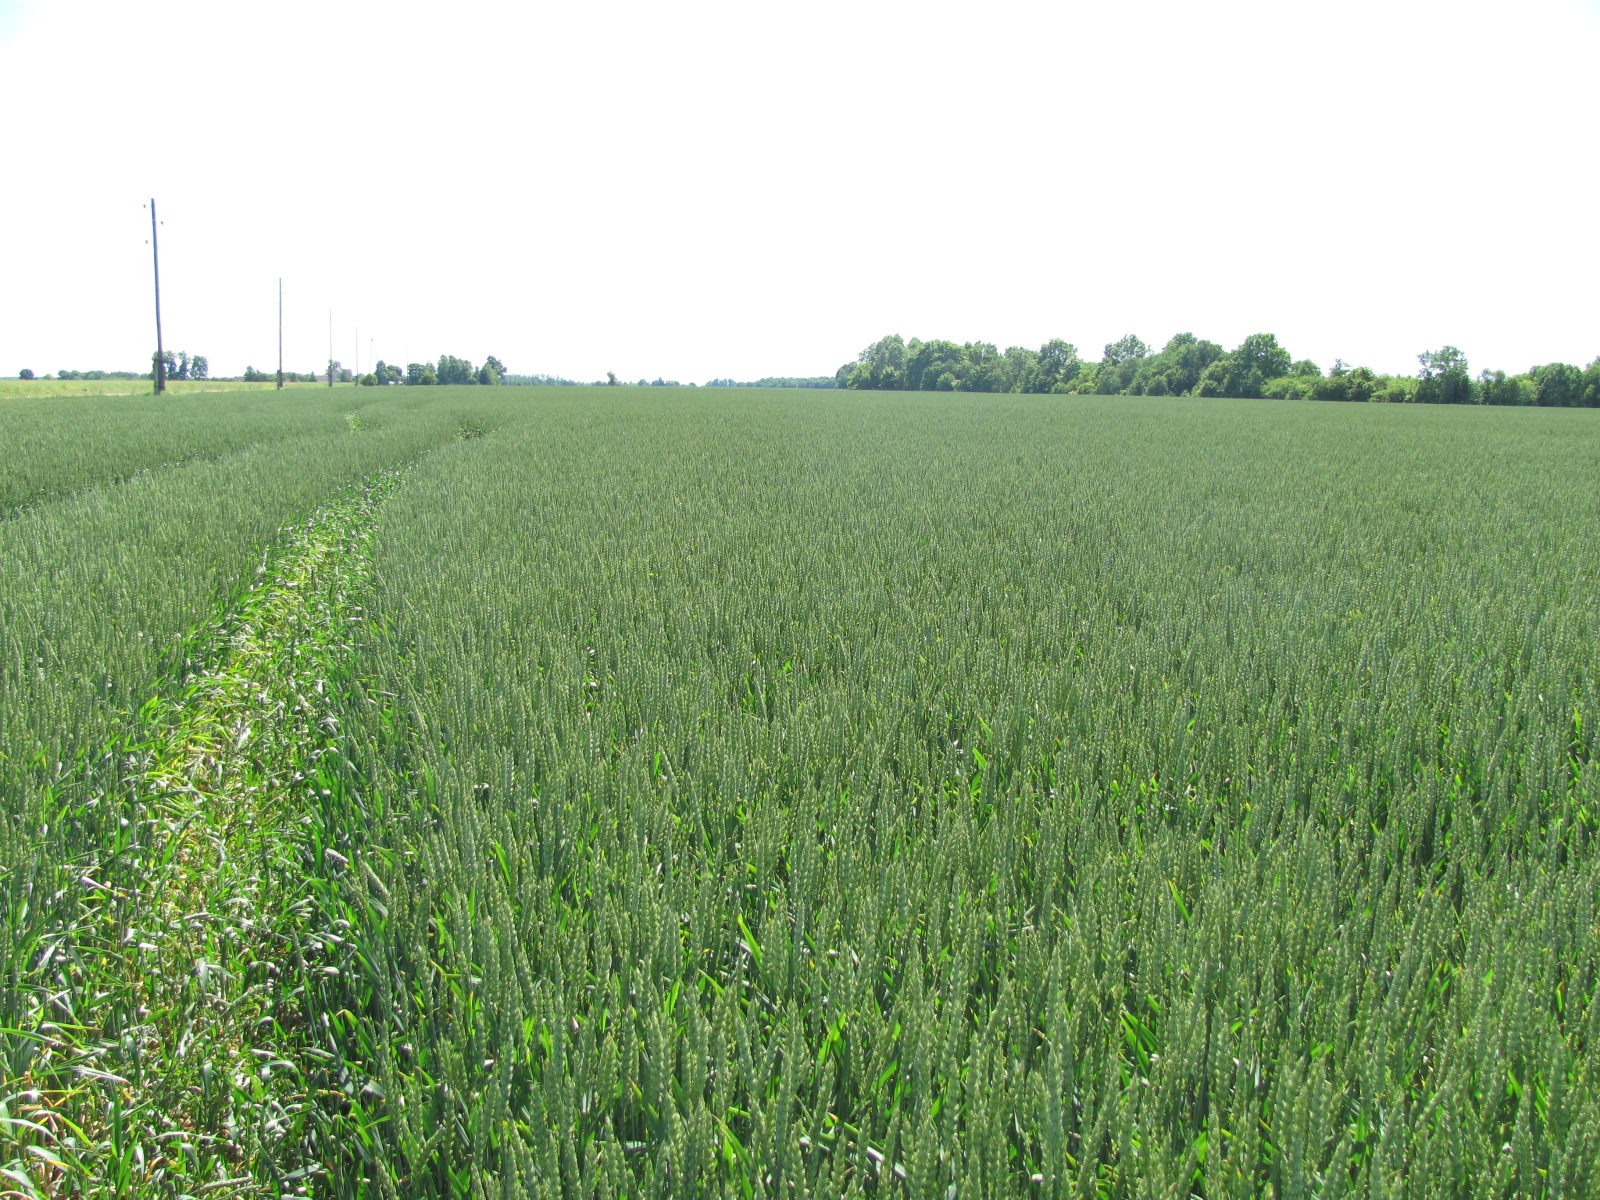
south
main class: Cropland
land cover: Common wheat
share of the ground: > 75 %
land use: Agriculture (excluding fallow land and kitchen gardens)
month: July
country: LV
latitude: 56.4471
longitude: 23.7561
